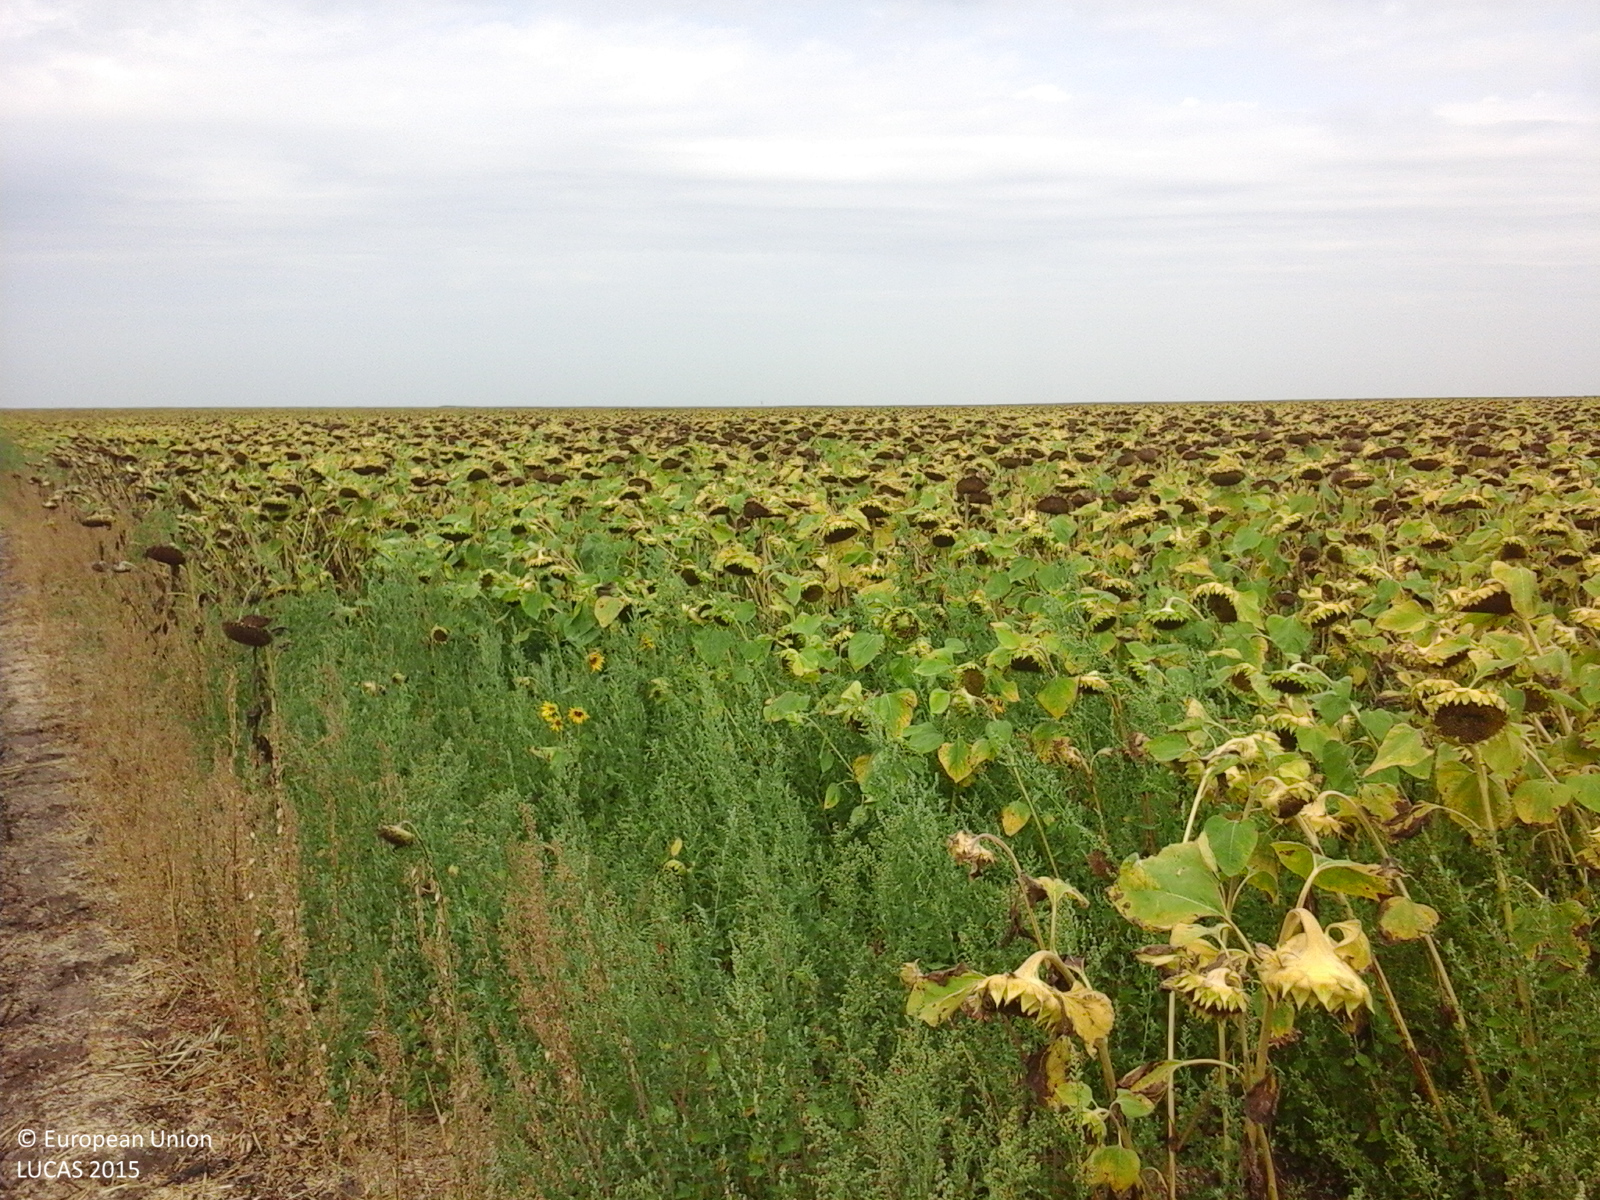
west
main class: Cropland
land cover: Sunflower
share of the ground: > 75 %
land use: Agriculture (excluding fallow land and kitchen gardens)
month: August
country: RO
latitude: 43.9533
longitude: 28.4456
